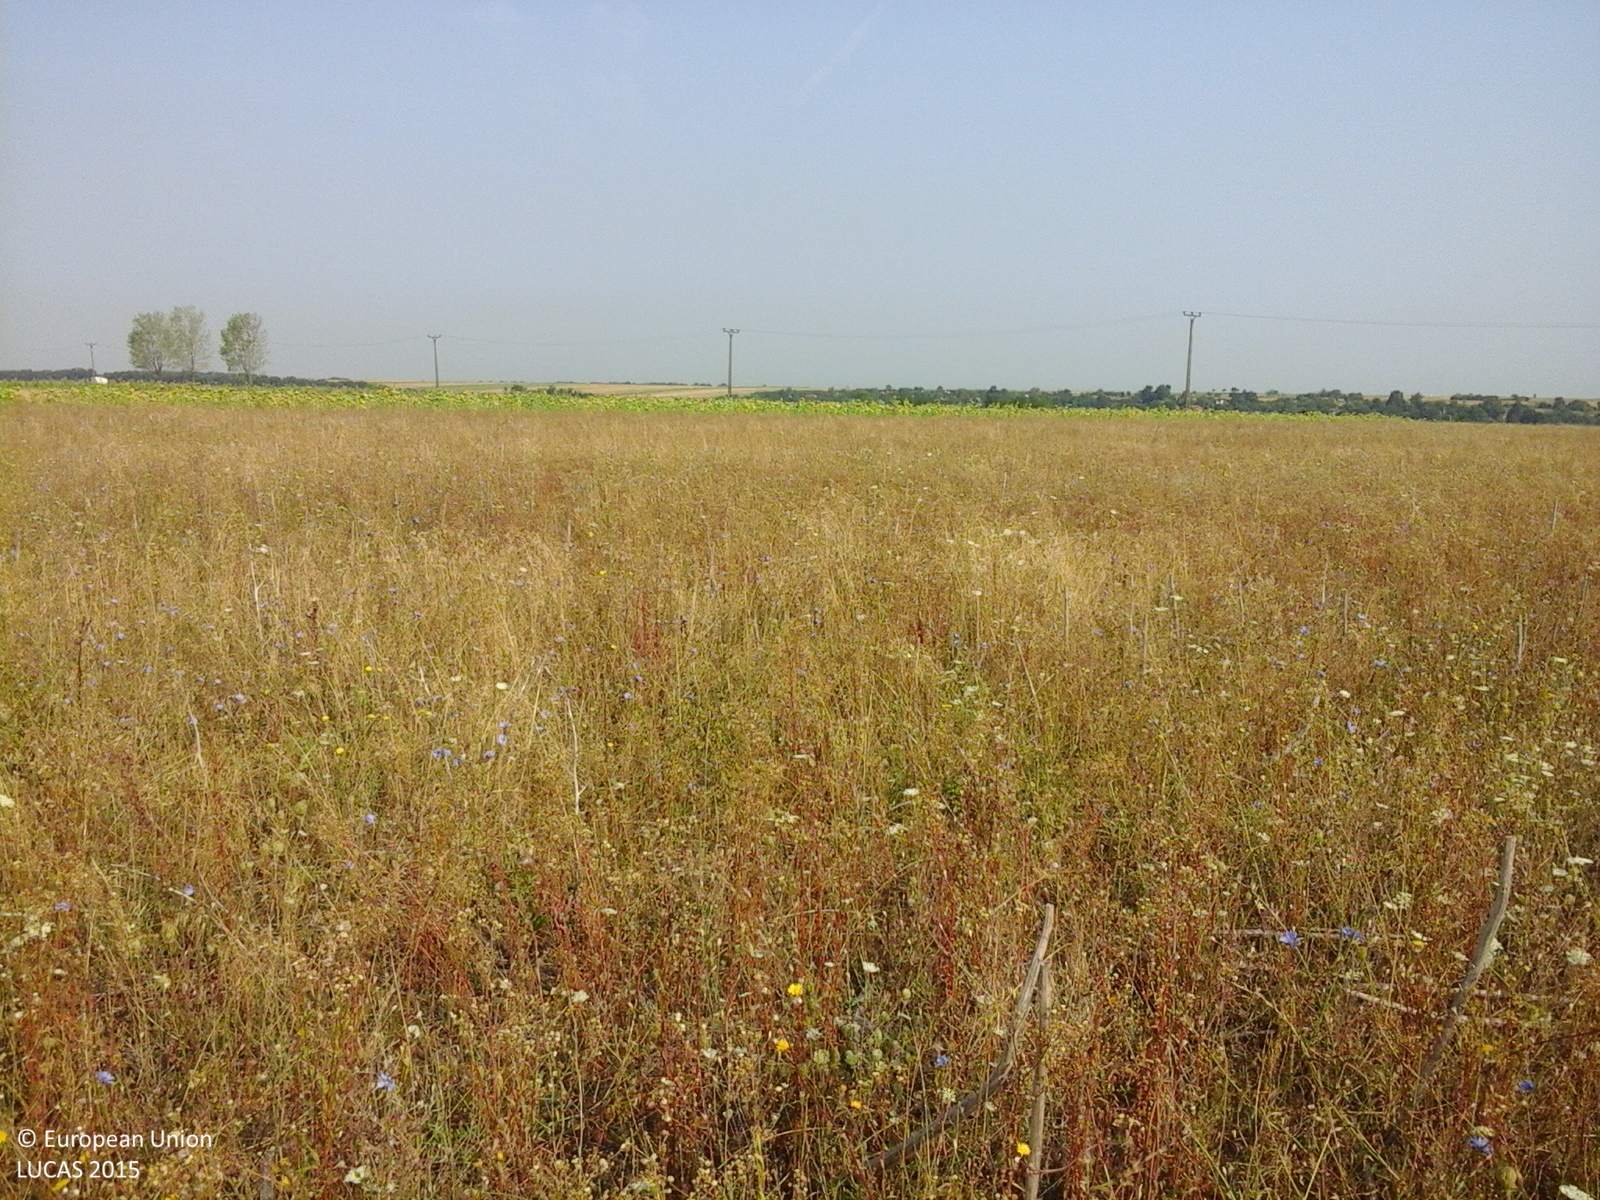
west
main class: Grassland
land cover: Spontaneously vegetated surfaces
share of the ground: > 75 %
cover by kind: herbaceous plants 100 %
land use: Fallow land
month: August
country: RO
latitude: 44.4725
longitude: 23.1849
